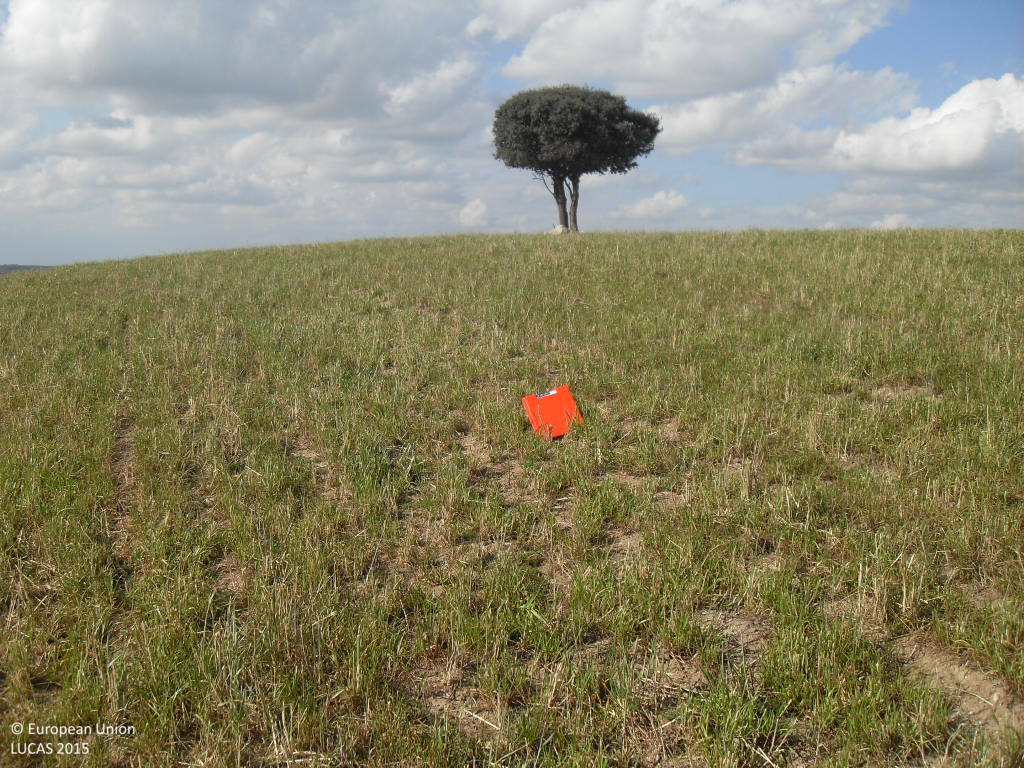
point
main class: Cropland
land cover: Rye
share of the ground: > 75 %
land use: Agriculture (excluding fallow land and kitchen gardens)
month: April
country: ES
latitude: 40.7265
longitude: -5.3288
